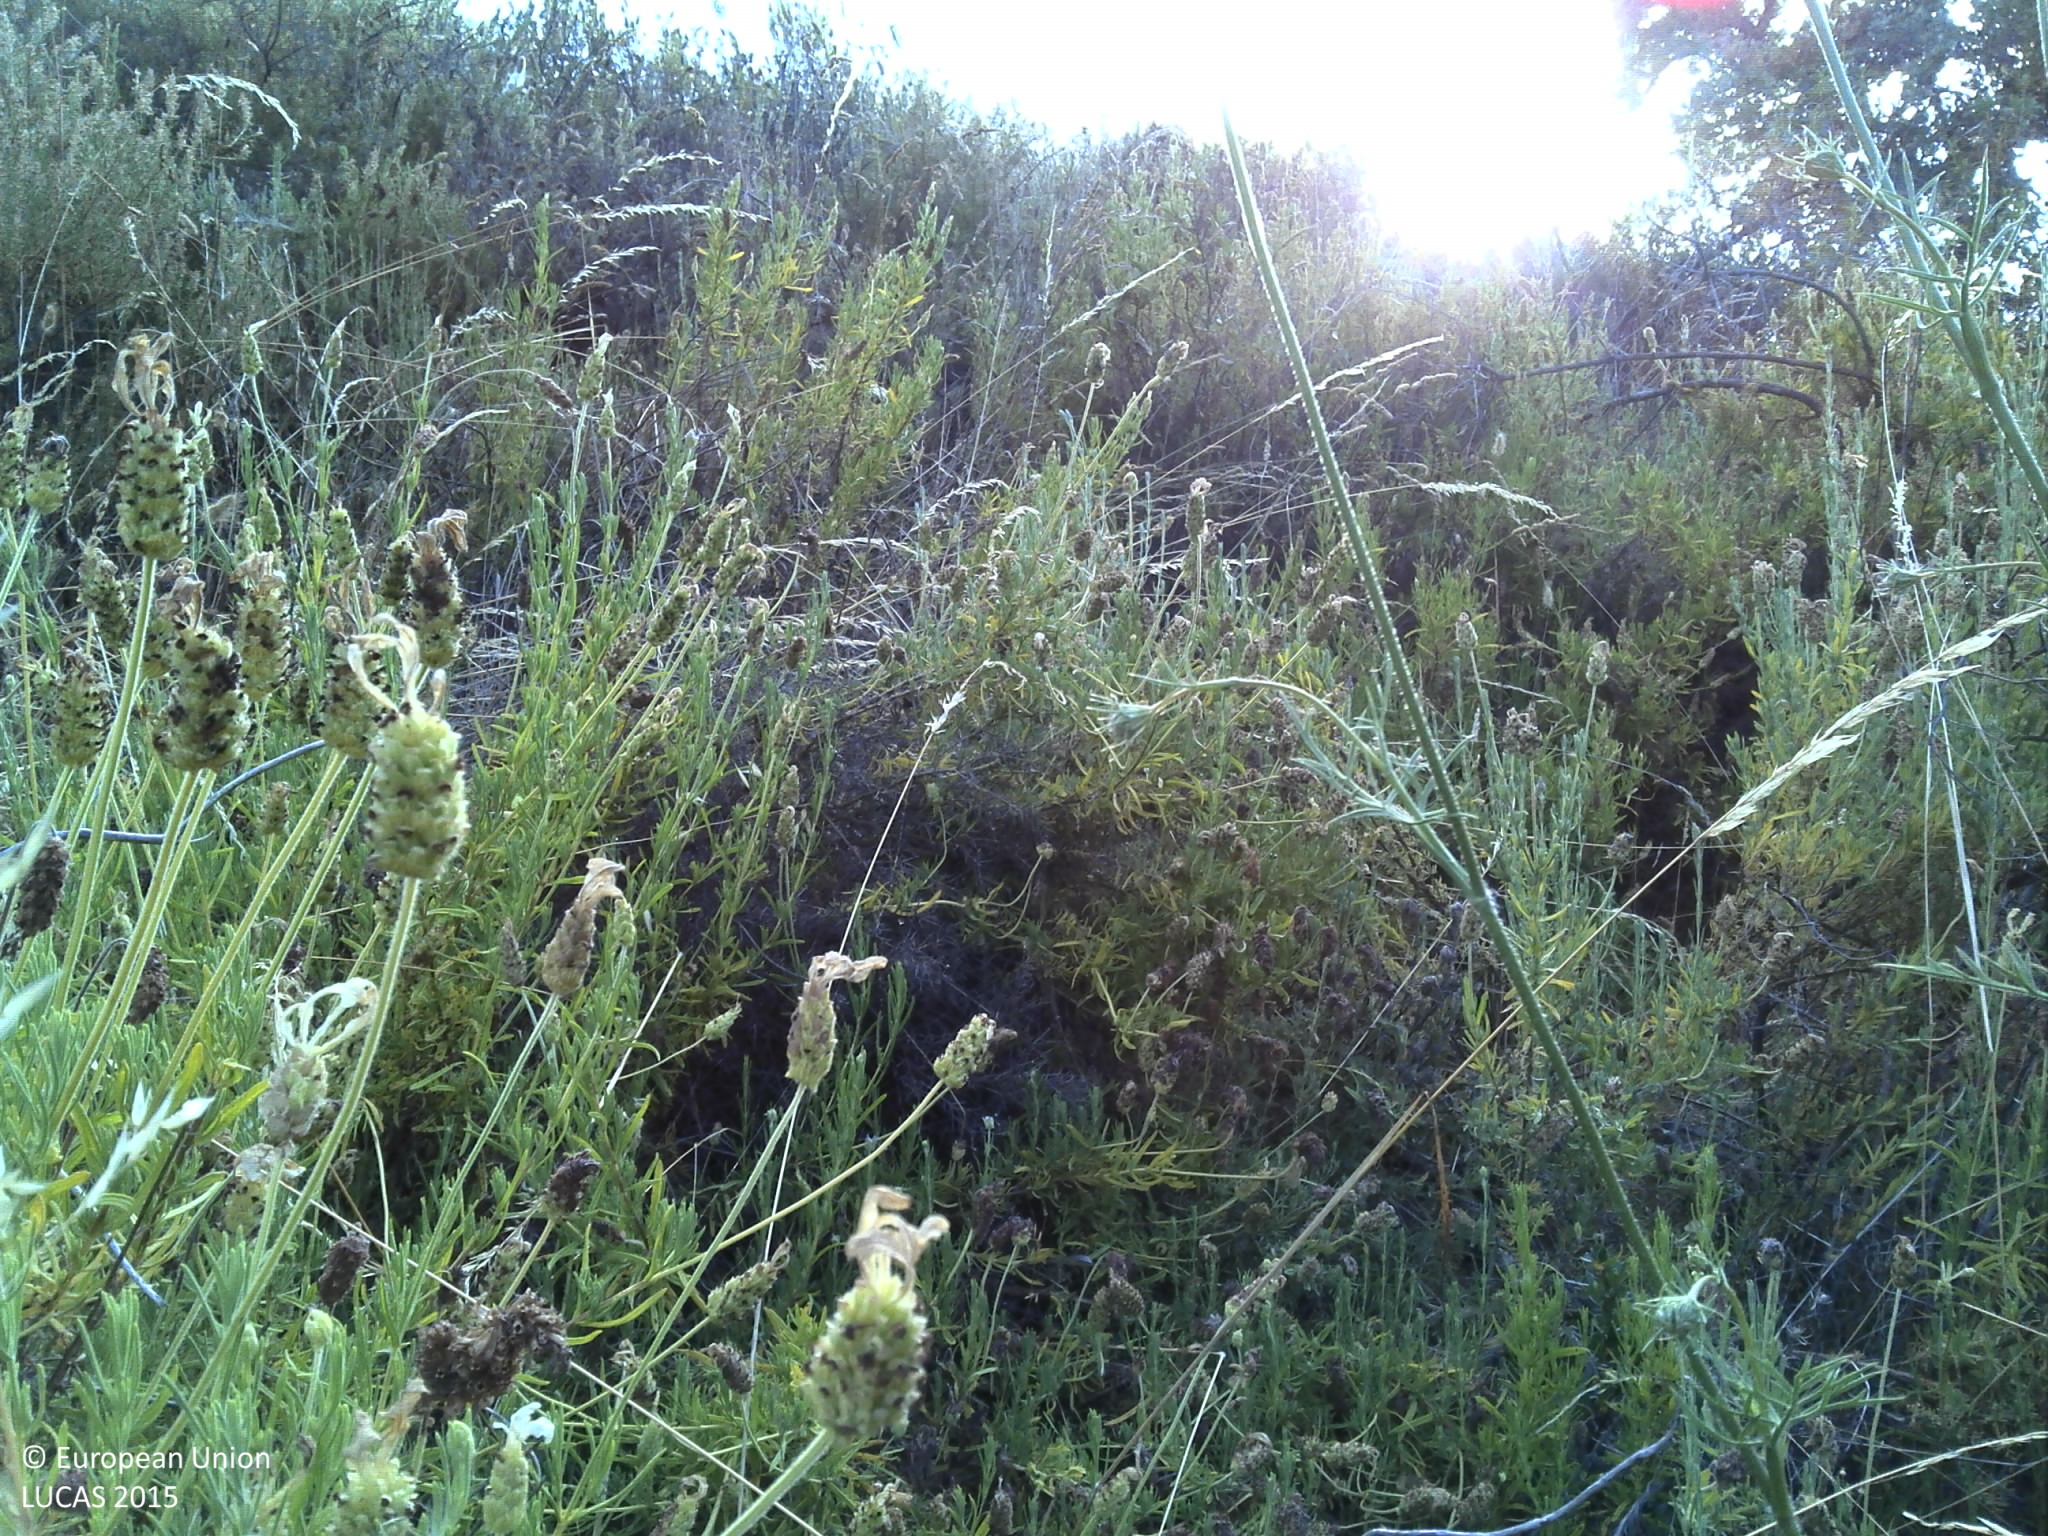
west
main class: Shrubland
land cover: Shrubland with sparse tree cover
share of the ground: > 75 %
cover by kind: shrubs 95 %, broadleaved forest trees 5 %
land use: Abandoned areas
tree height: < 5 m
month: June
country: PT
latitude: 37.7465
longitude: -7.4566
